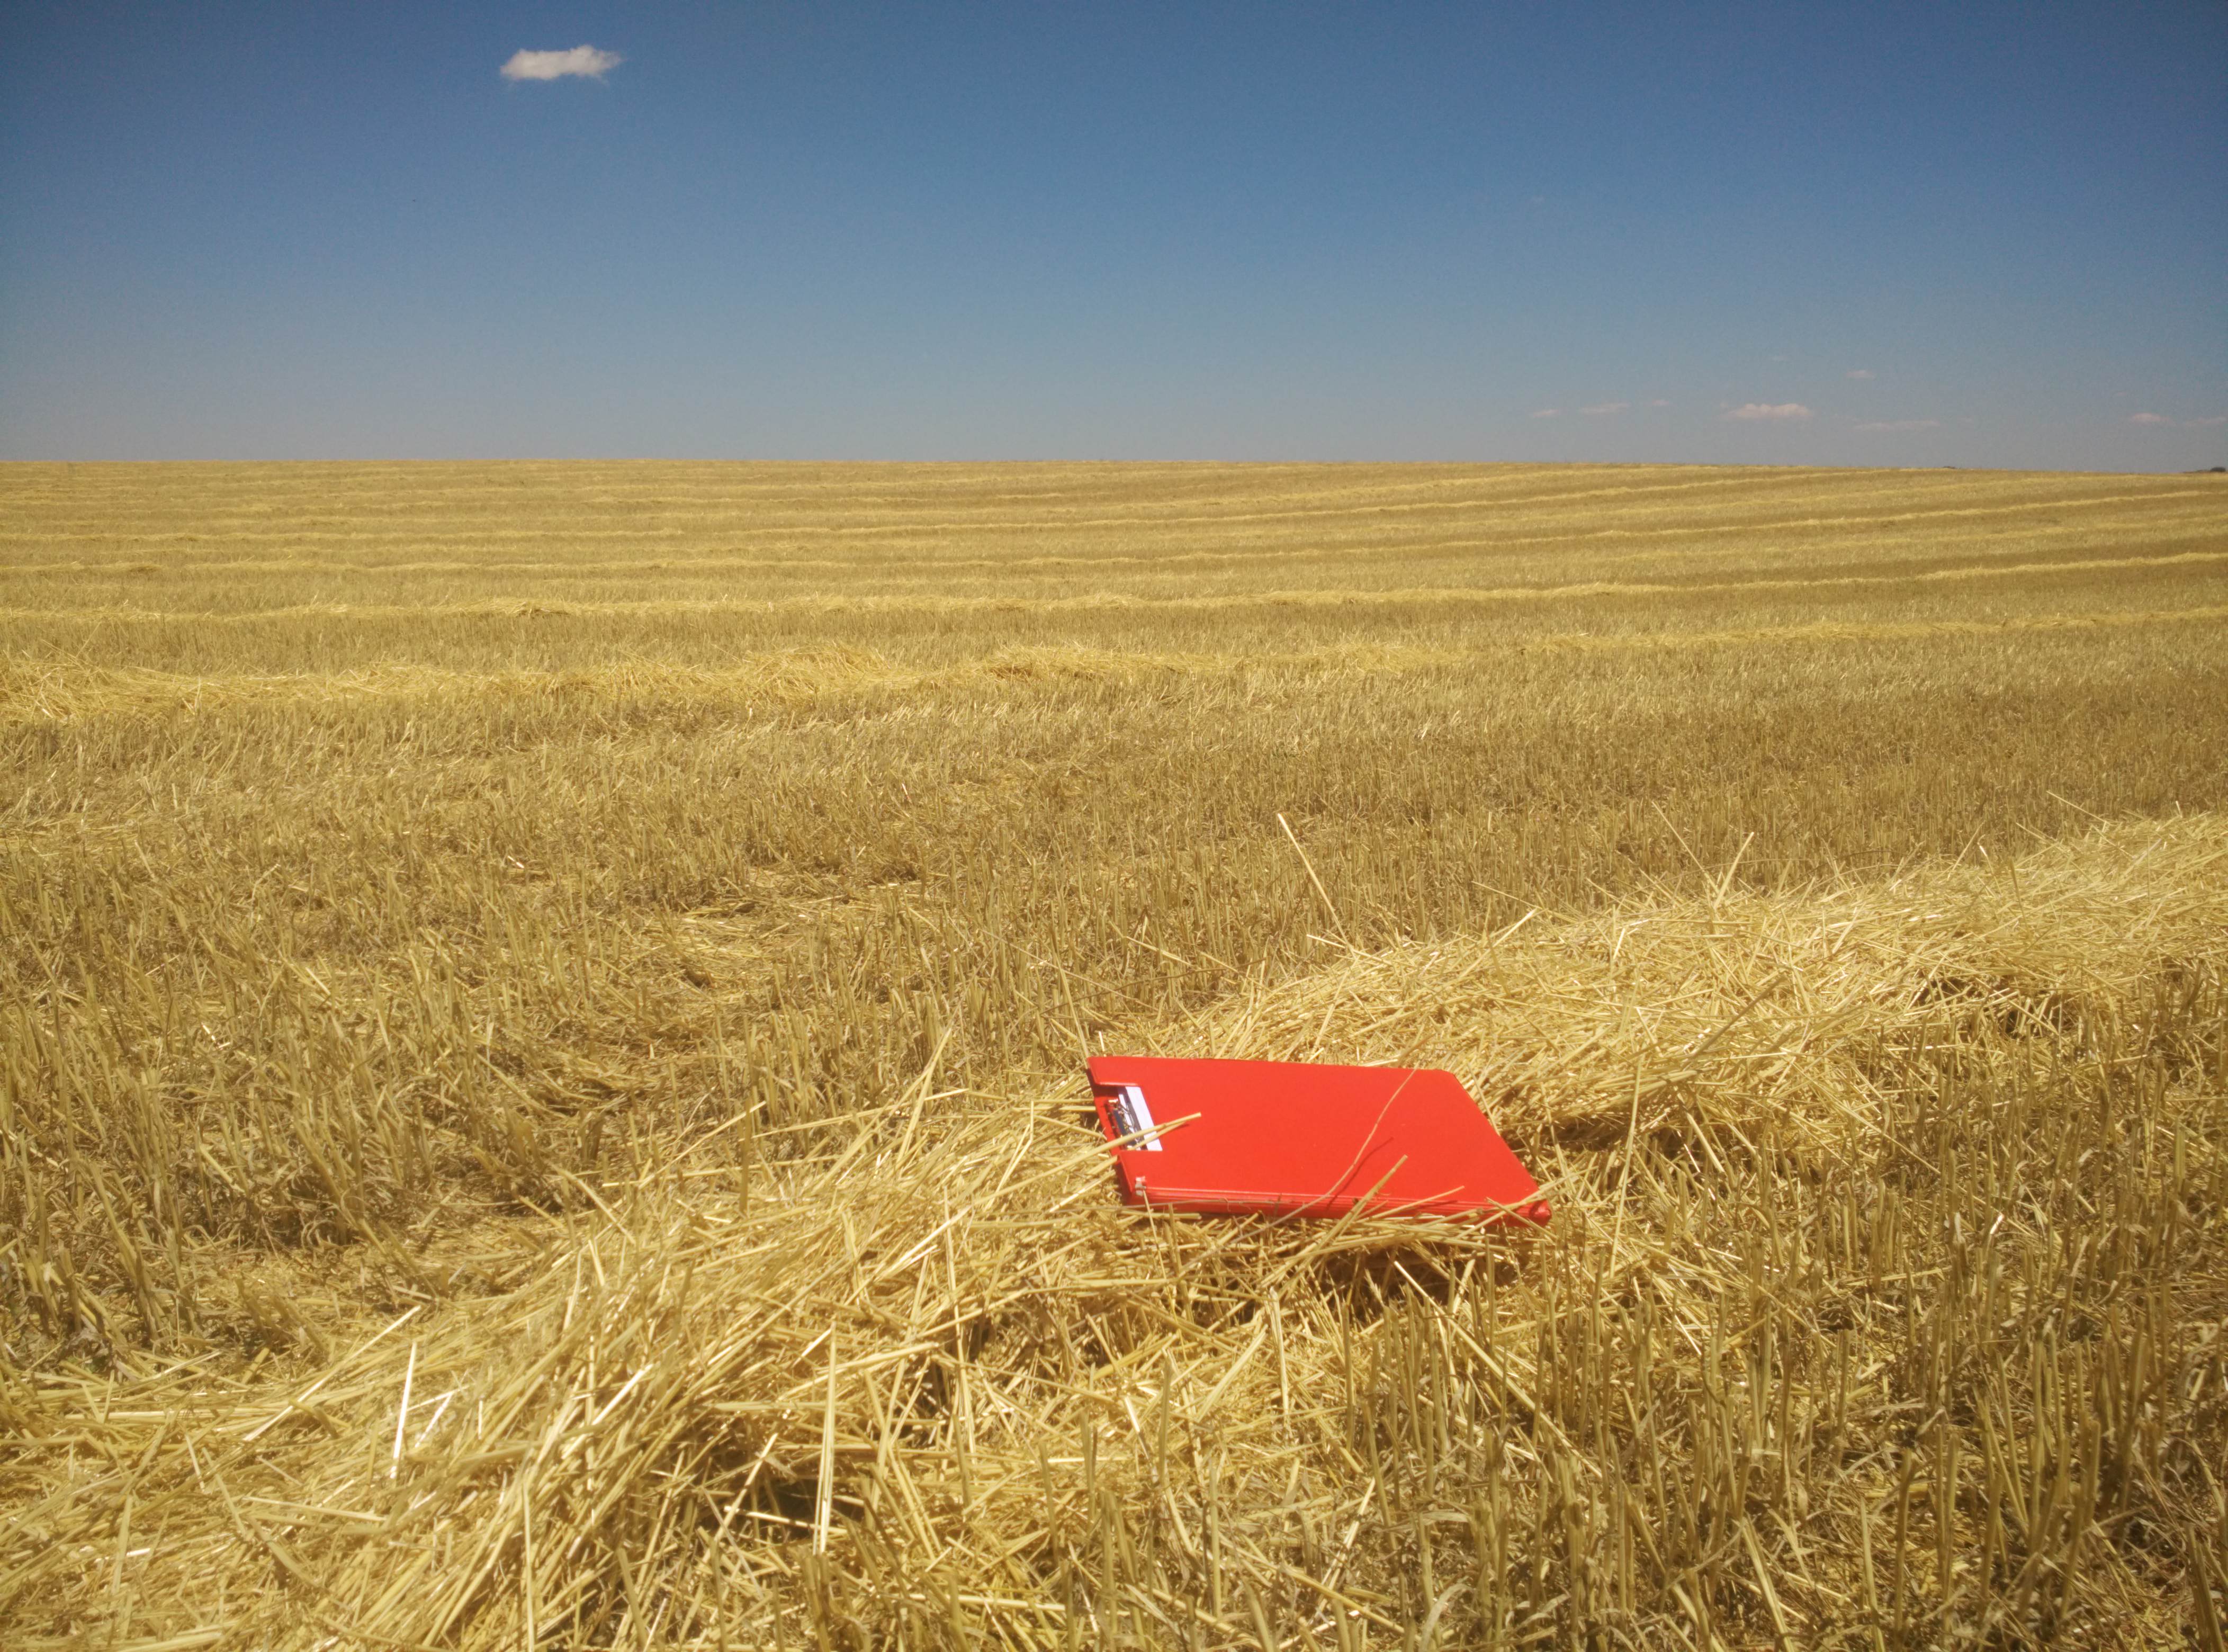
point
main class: Cropland
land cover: Common wheat
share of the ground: < 10 %
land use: Agriculture (excluding fallow land and kitchen gardens)
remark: Harvested field
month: July
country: ES
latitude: 40.8807
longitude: -2.7170
